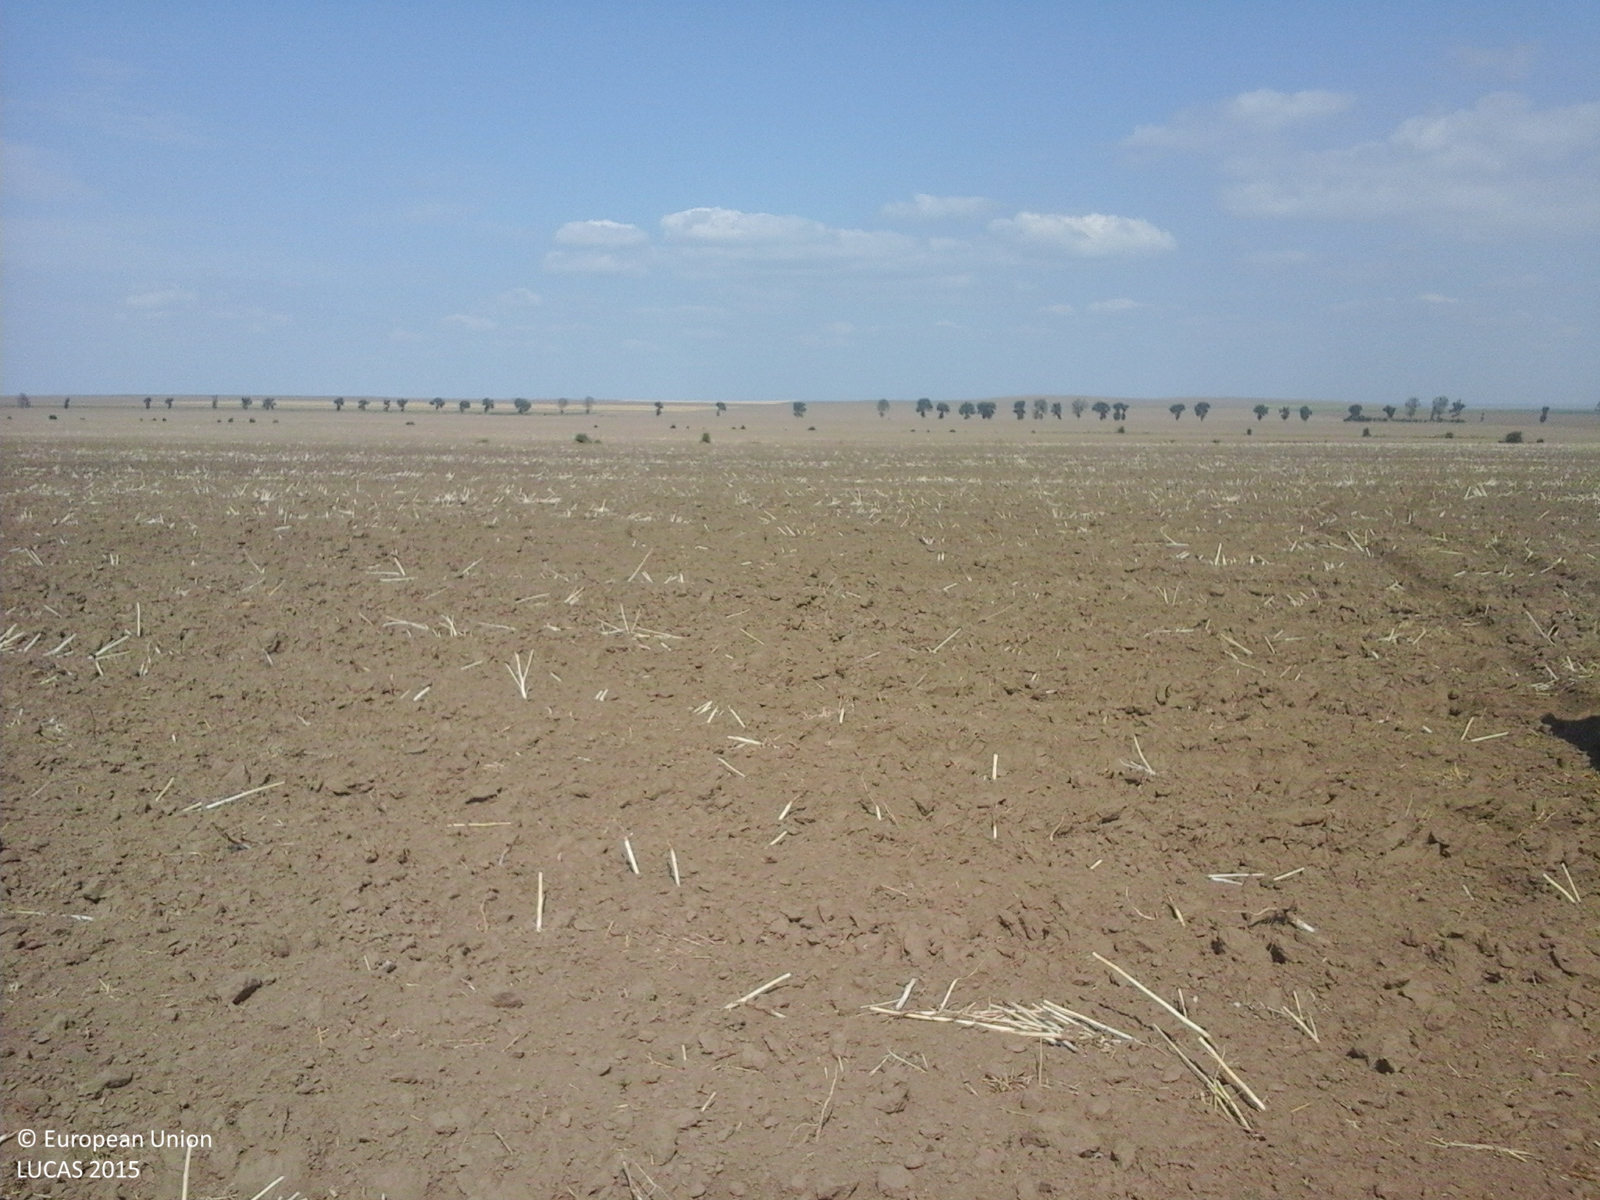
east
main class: Cropland
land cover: Rape and turnip rape
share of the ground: < 10 %
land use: Agriculture (excluding fallow land and kitchen gardens)
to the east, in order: Rape and turnip rape
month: August
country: RO
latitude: 44.8182
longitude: 28.8680
